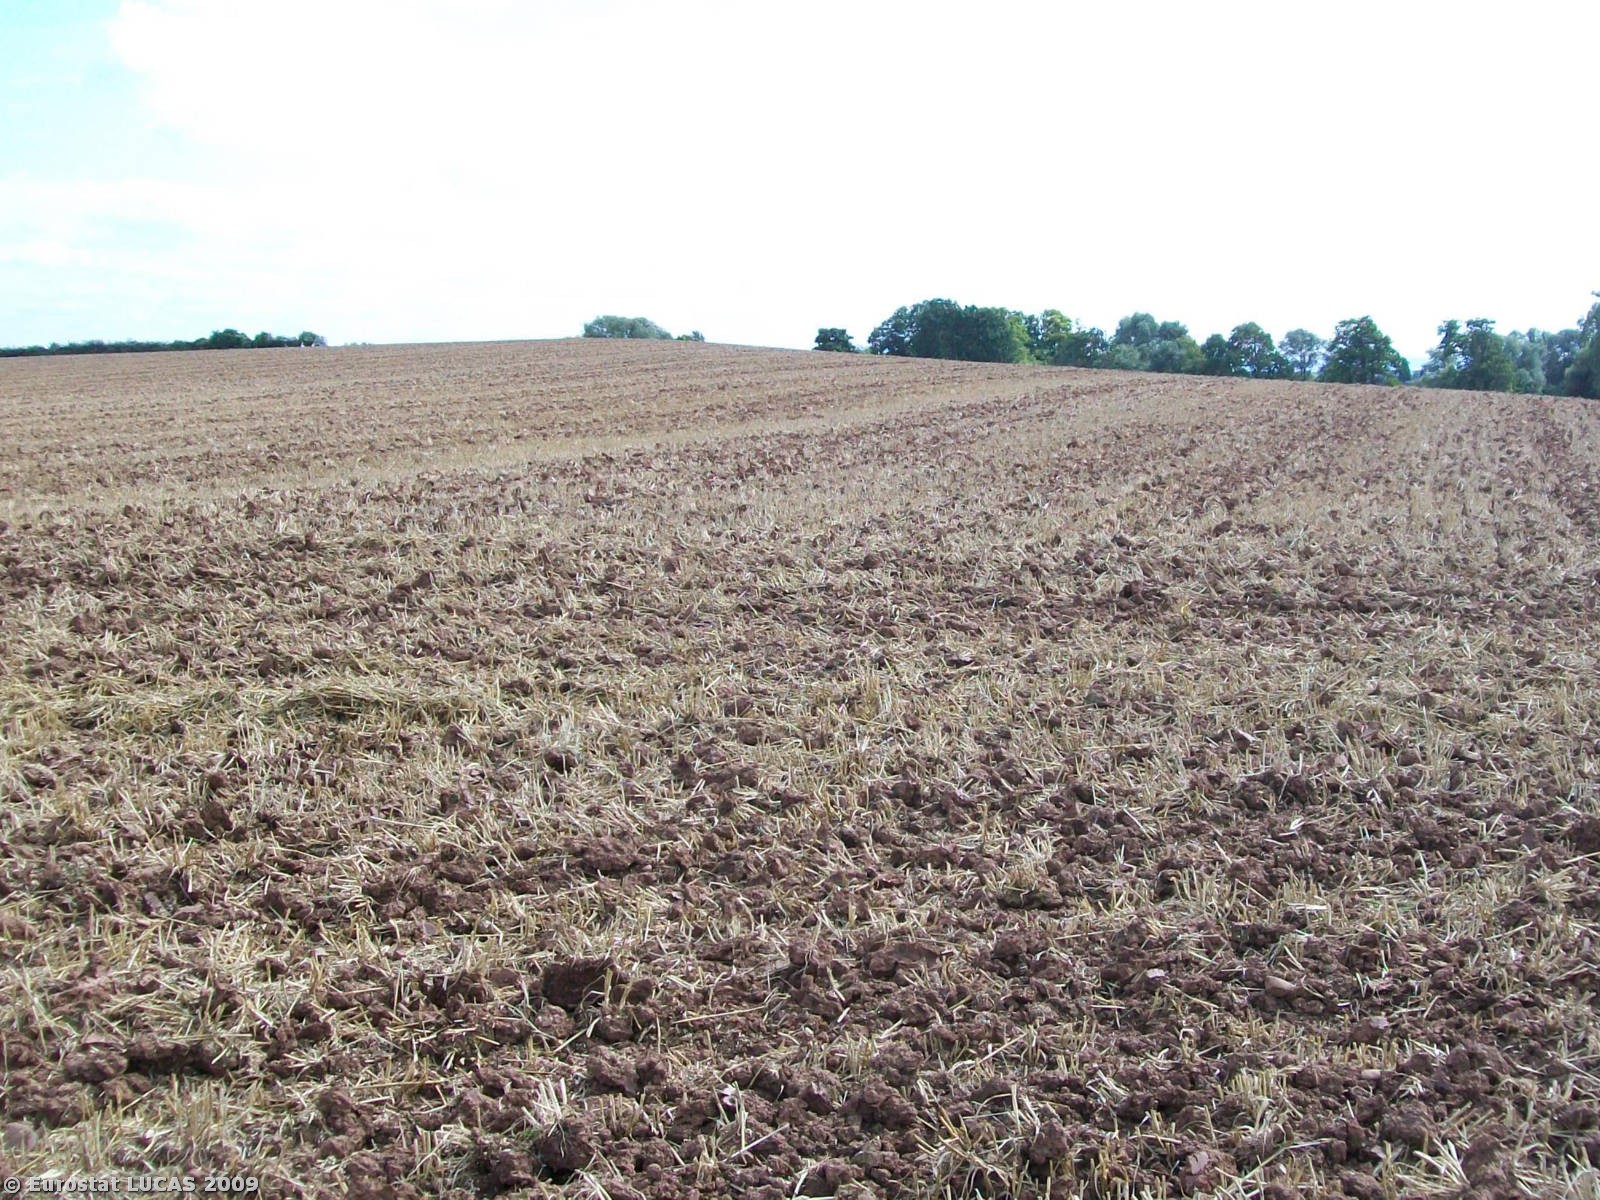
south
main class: Cropland
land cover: Common wheat
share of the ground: < 10 %
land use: Agriculture (excluding fallow land and kitchen gardens)
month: August
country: GB
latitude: 51.8733
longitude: -2.3667
